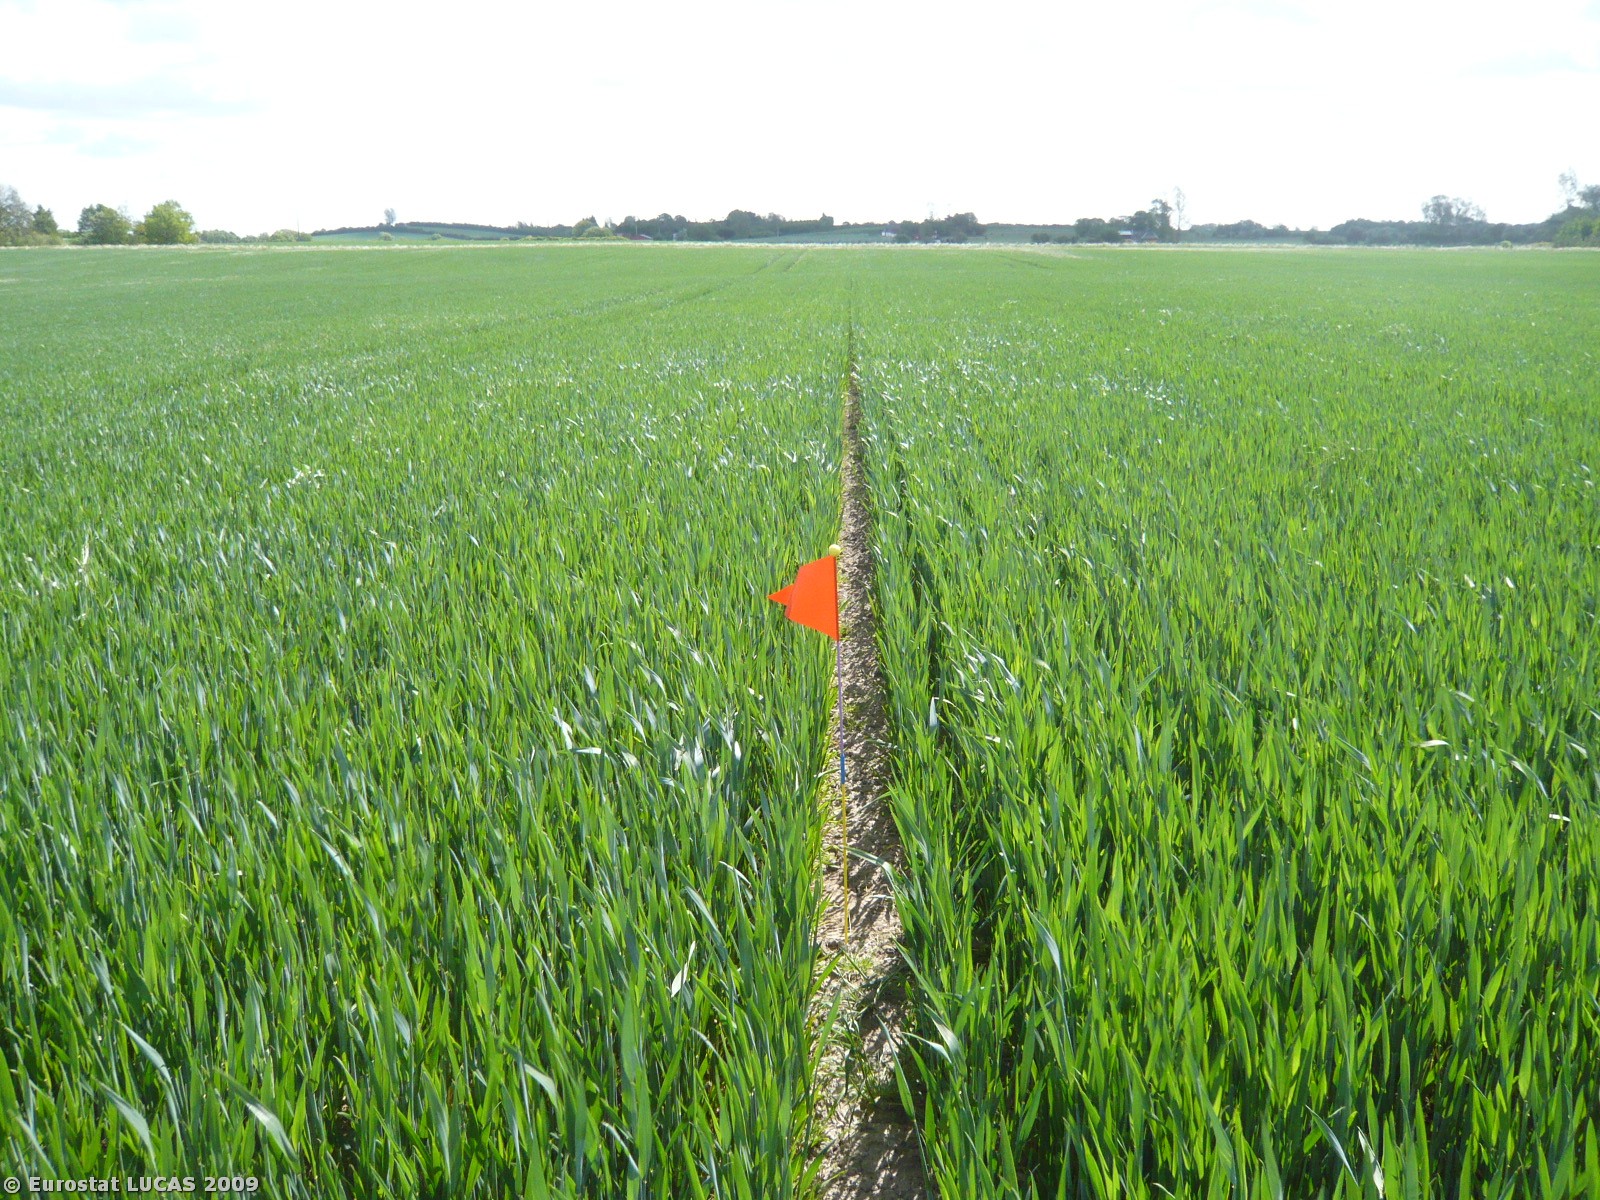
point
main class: Cropland
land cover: Common wheat
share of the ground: > 75 %
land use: Agriculture (excluding fallow land and kitchen gardens)
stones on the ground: < 10 %
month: May
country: DK
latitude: 55.2782
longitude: 11.6516
